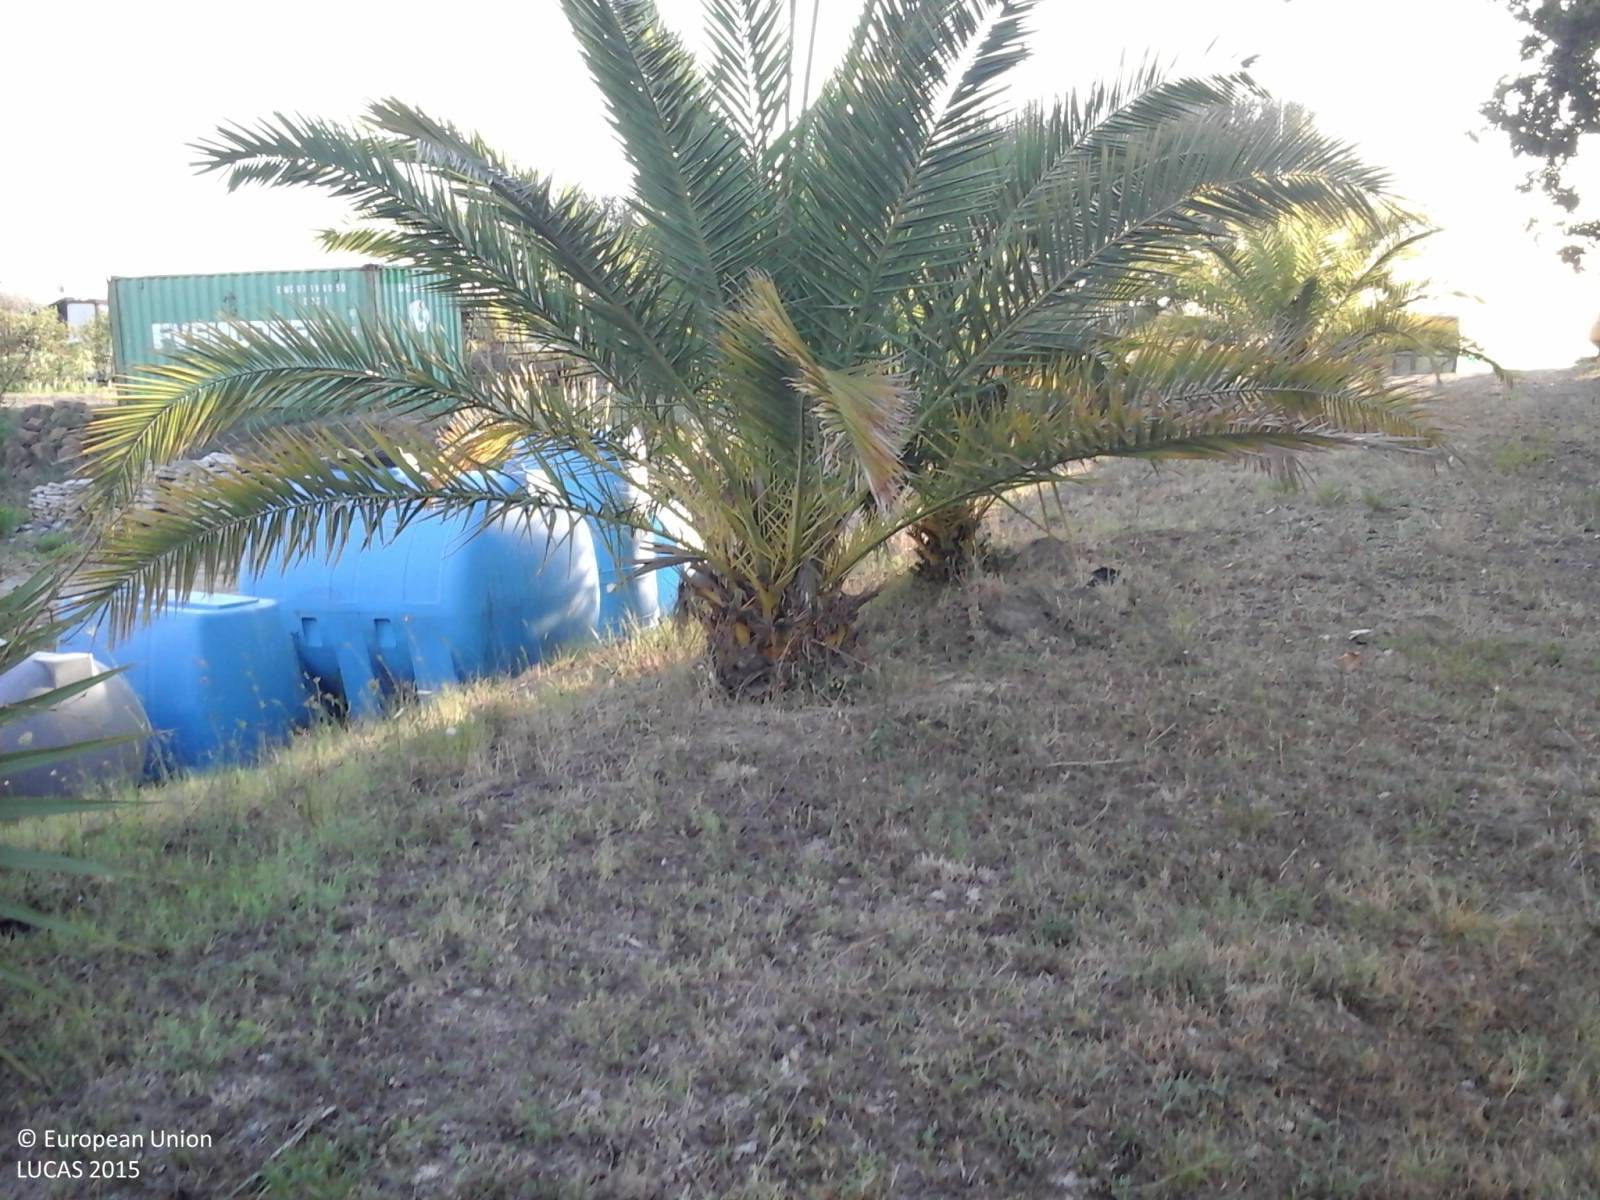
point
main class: Grassland
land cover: Grassland without tree/shrub cover
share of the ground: > 75 %
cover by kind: herbaceous plants 100 %
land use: Agriculture (excluding fallow land and kitchen gardens)
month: July
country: IT
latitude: 42.0660
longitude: 12.3722
